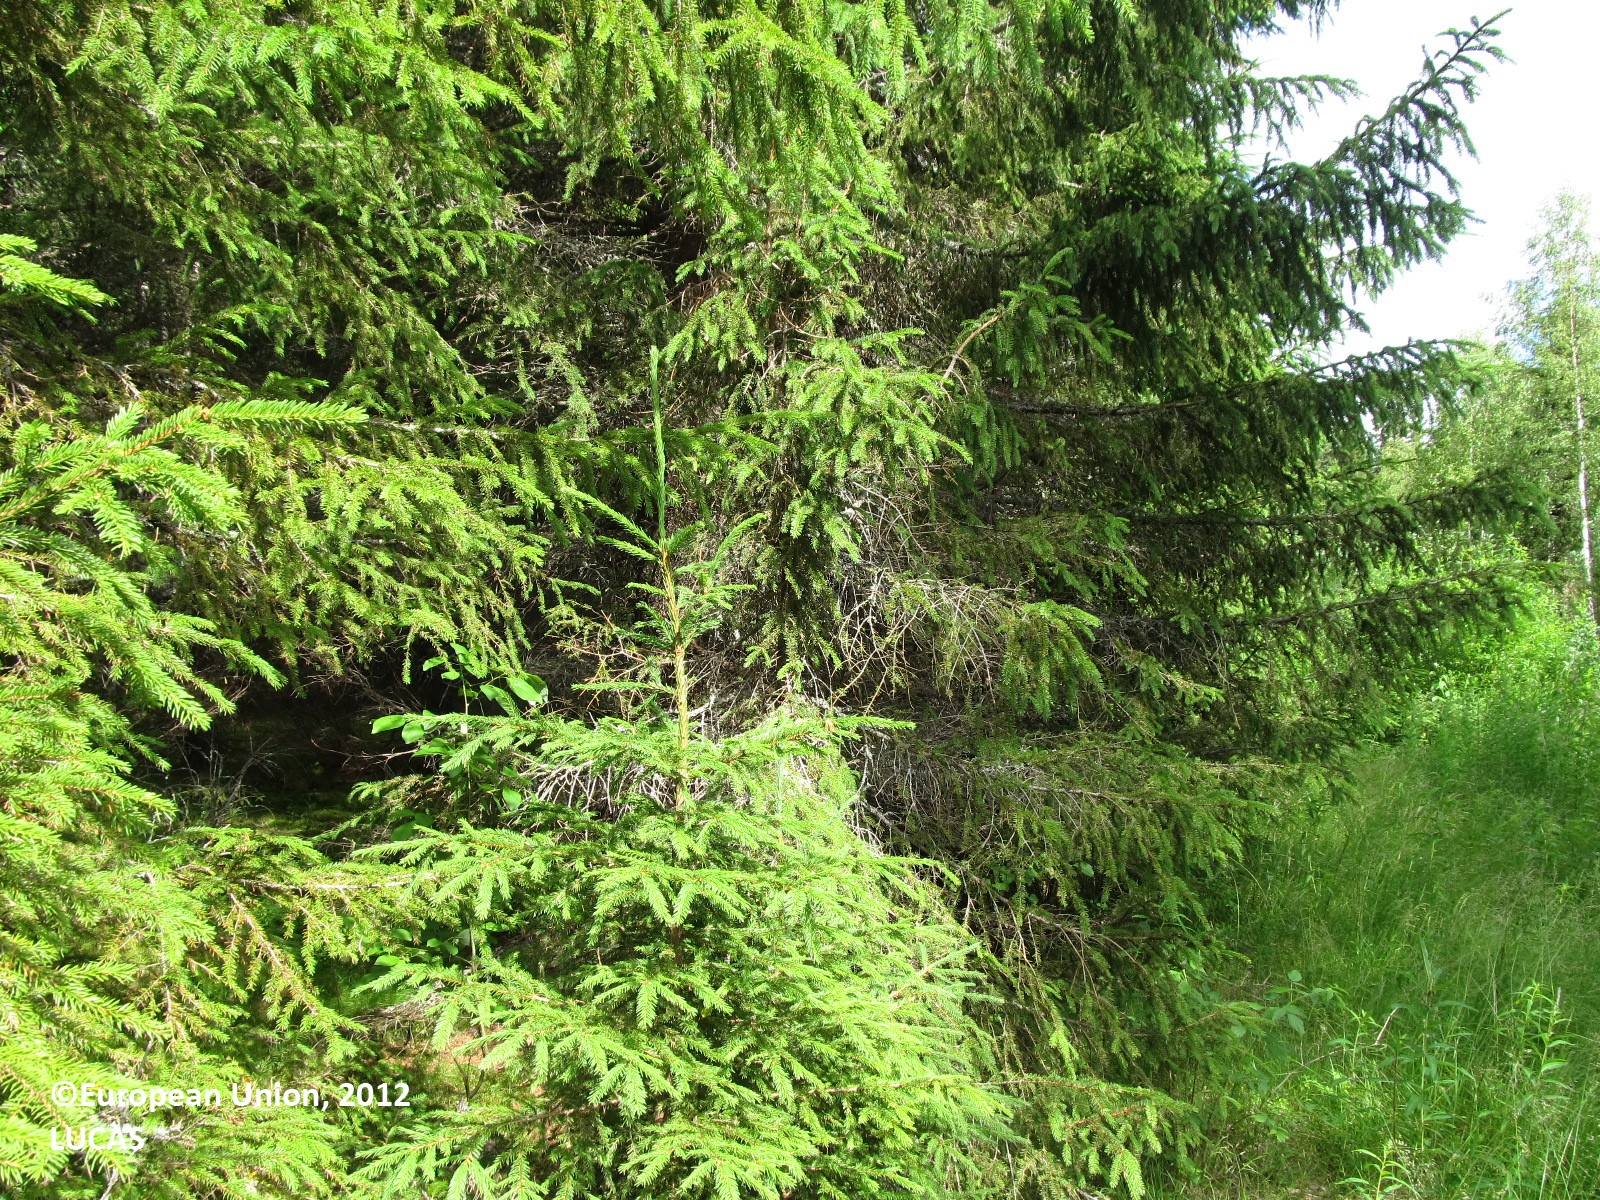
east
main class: Woodland
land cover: Spruce dominated mixed woodland
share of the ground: 25 - 50 %
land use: Forestry
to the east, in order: Spruce dominated mixed woodland; Tracks; Ditches and canals; Spruce dominated coniferous woodland
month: July
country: FI
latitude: 62.0455
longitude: 28.7845
